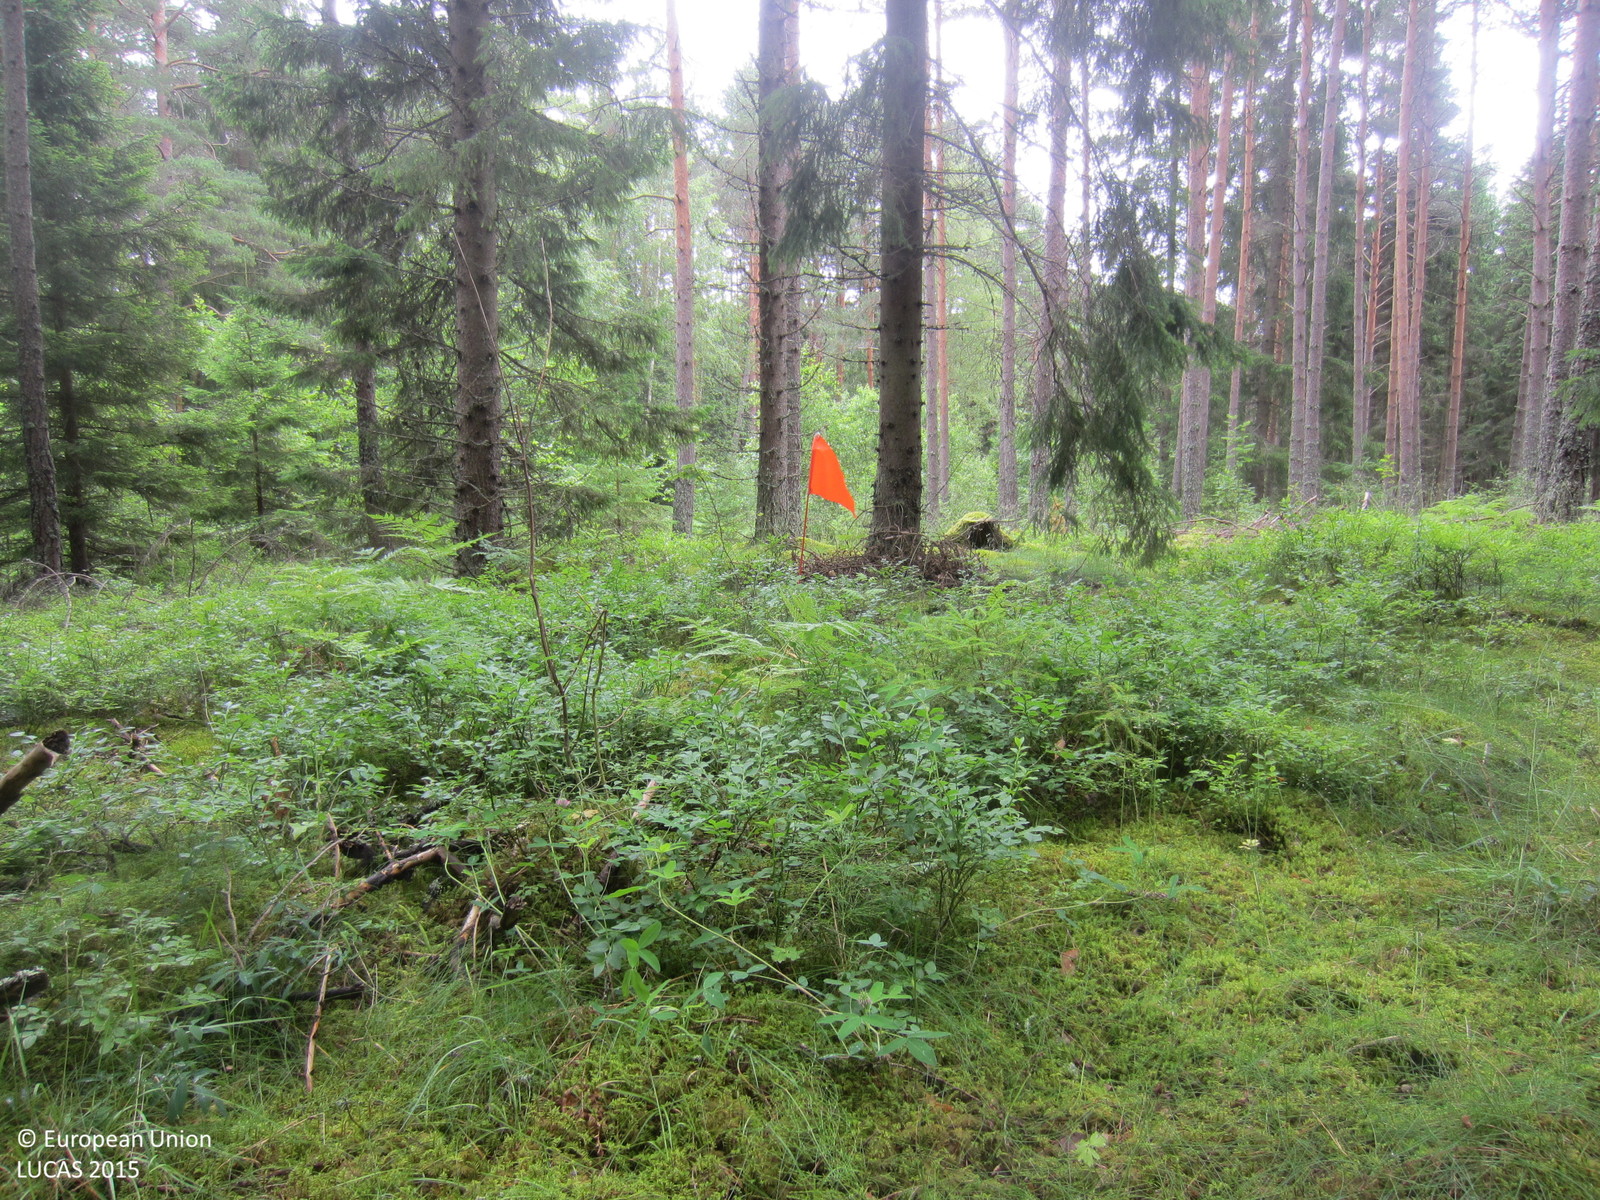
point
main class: Woodland
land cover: Spruce dominated coniferous woodland
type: boreal forest
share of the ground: > 75 %
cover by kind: coniferous forest trees 70 %, herbaceous plants 10 %, lichens and mosses 10 %, broadleaved forest trees 5 %, shrubs 5 %
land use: Forestry
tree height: > 5 m
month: July
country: SE
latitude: 59.8241
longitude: 17.0376
